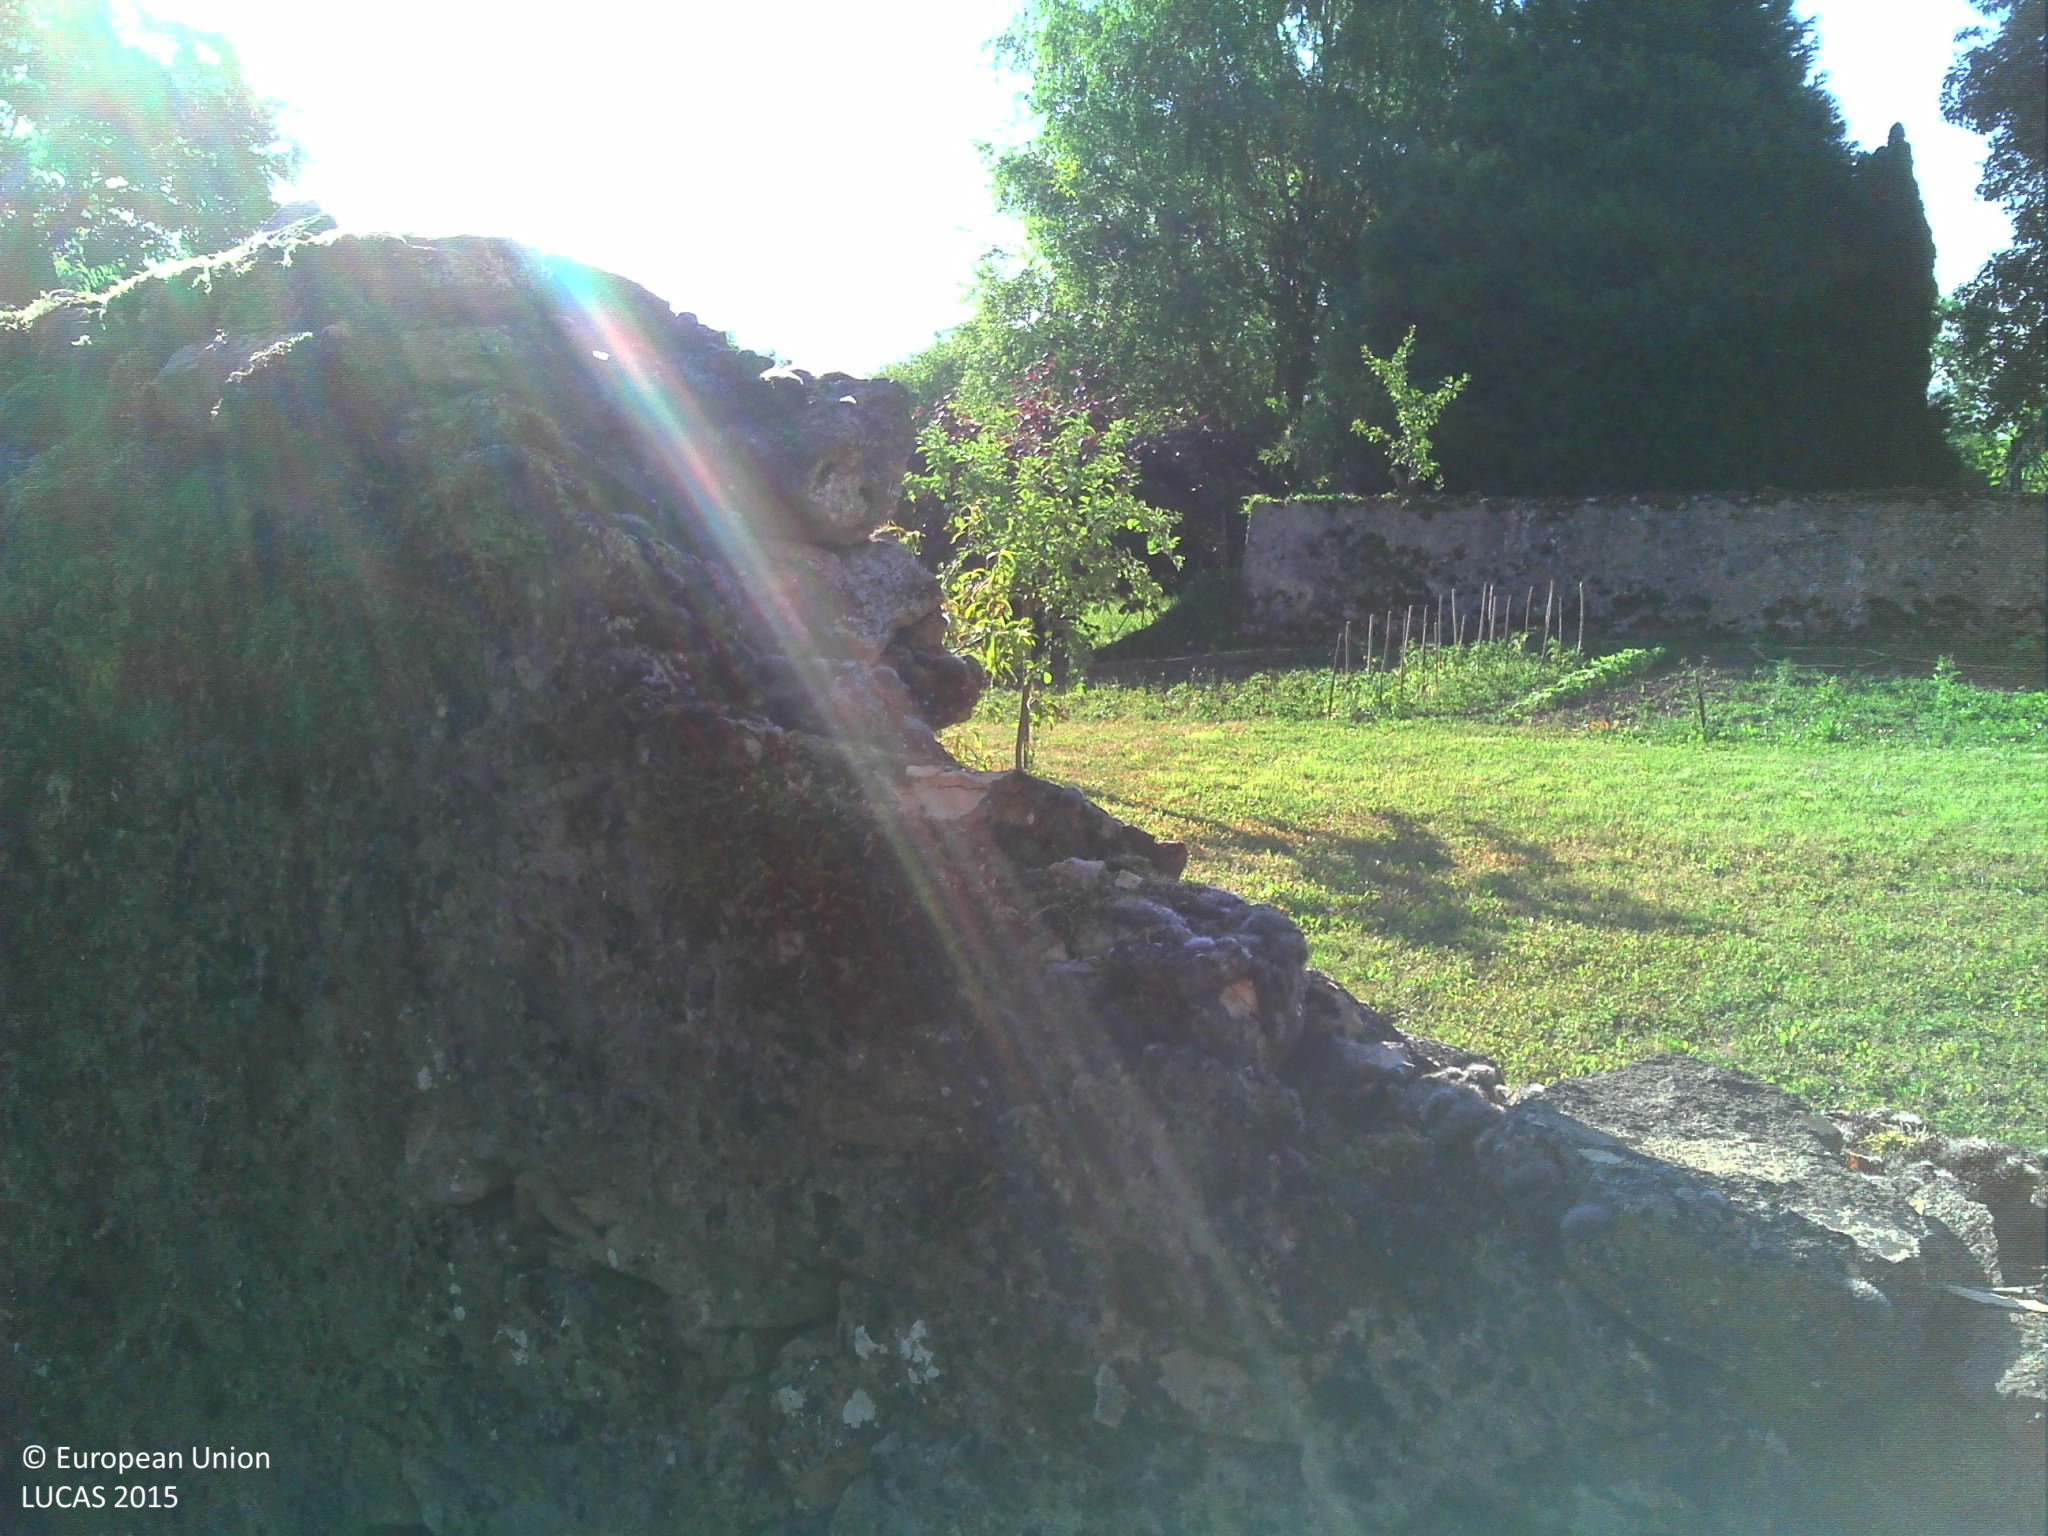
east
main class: Cropland
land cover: Cherry fruit
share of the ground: 50 - 75 %
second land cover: Other fruit trees and berries
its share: 50 - 75 %
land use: Kitchen garden
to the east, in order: Dry stone walls; Artificial constructions in urban areas; Dry stone walls; Tracks; Dry stone walls; Broadleaved woodland; Fences; Electric lines; Tracks; Fences; Abandoned hedges; Grassland with sparse tree/shrub cover; Shrubland with sparse tree cover; Fences; Grassland with sparse tree/shrub cover; Artificial constructions in urban areas
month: June
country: FR
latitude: 48.9795
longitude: 5.9963
